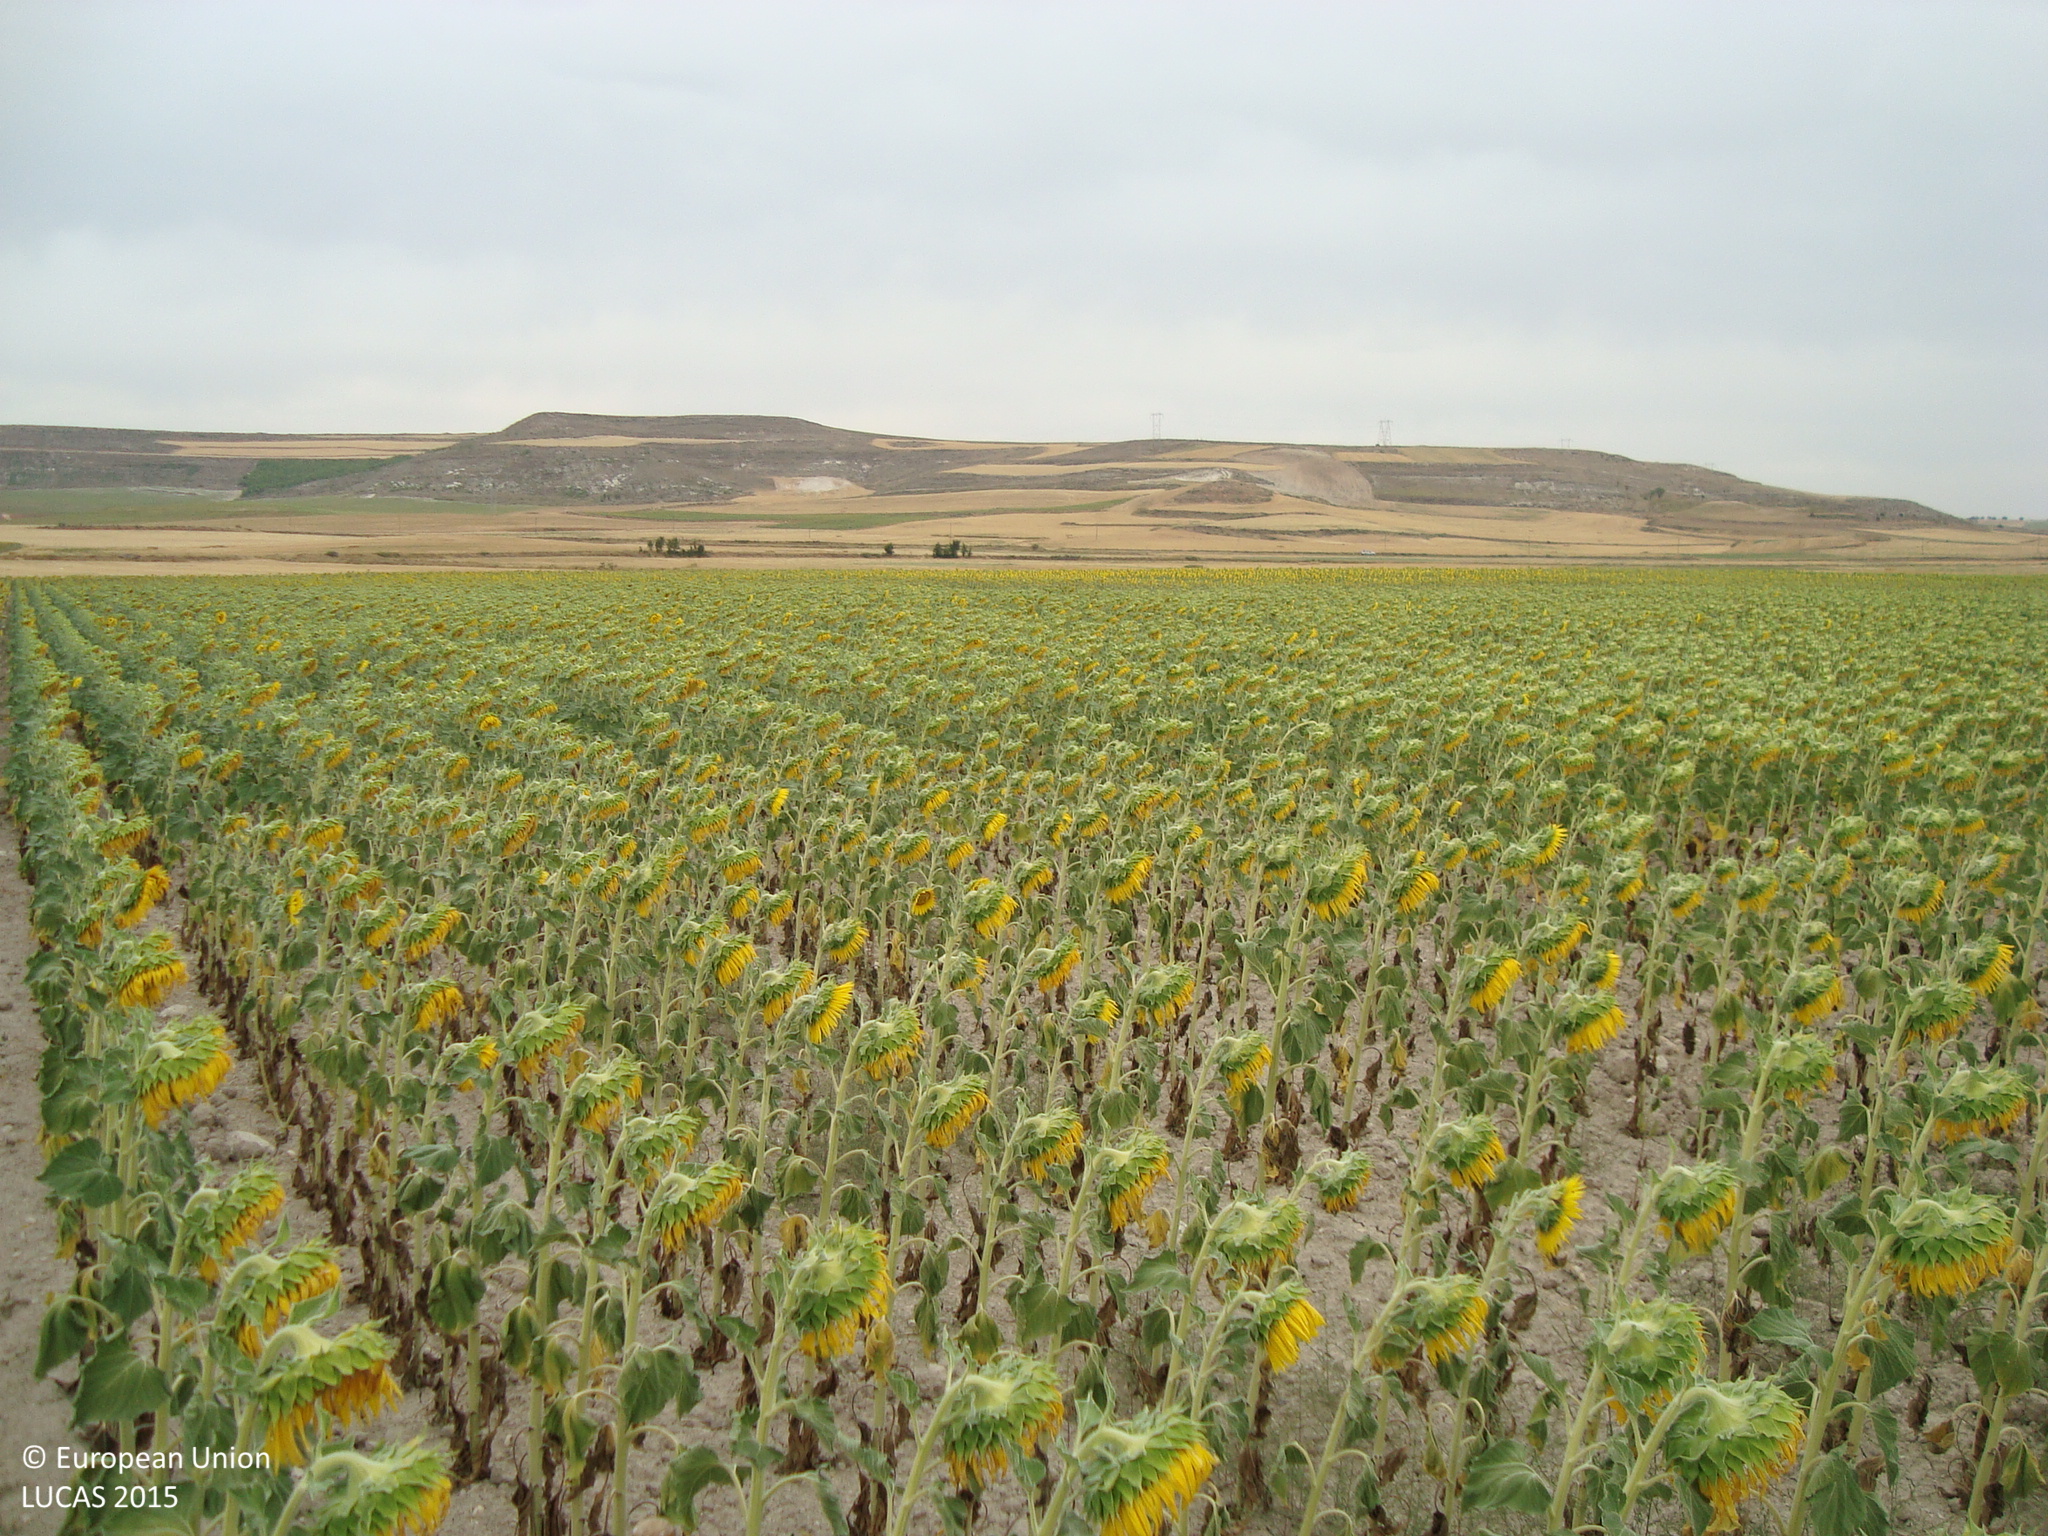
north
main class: Cropland
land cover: Sunflower
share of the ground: 50 - 75 %
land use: Agriculture (excluding fallow land and kitchen gardens)
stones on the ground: < 10 %
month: August
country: ES
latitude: 42.1953
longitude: -3.9529
